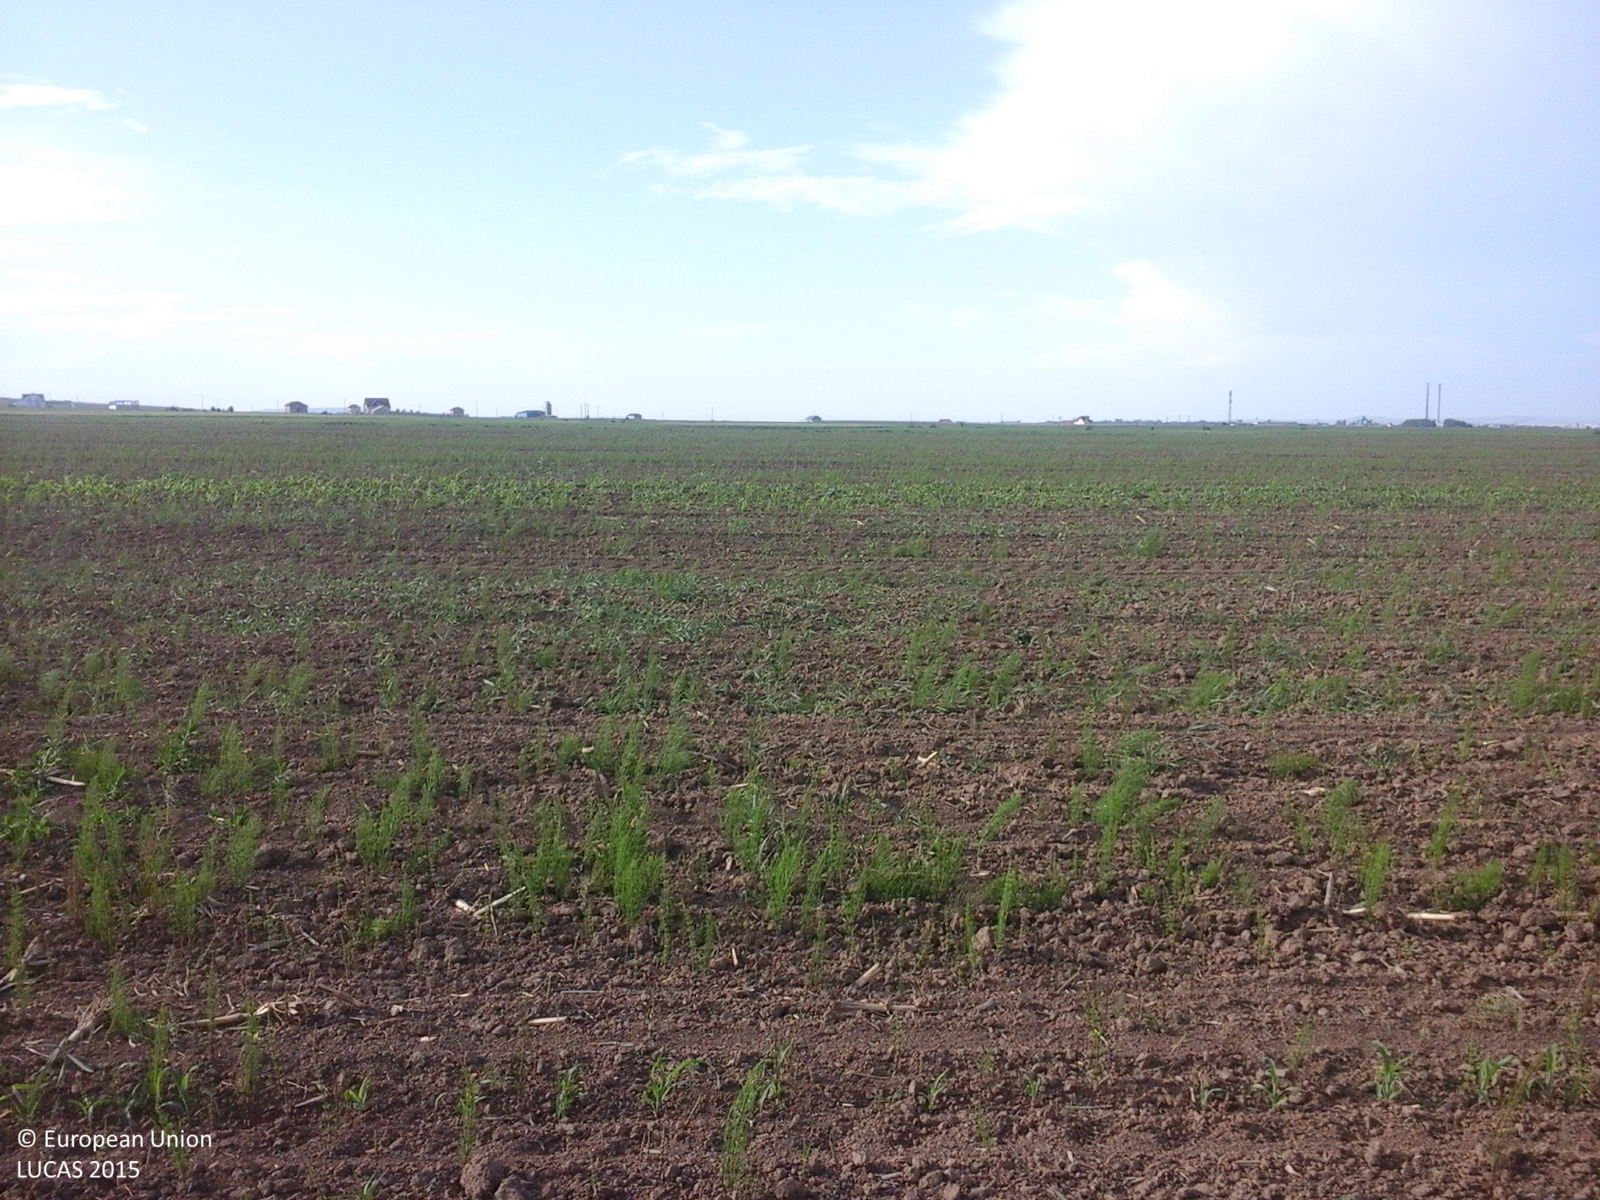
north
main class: Cropland
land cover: Maize
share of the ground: < 10 %
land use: Agriculture (excluding fallow land and kitchen gardens)
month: June
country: RO
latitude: 46.4642
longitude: 26.9039
